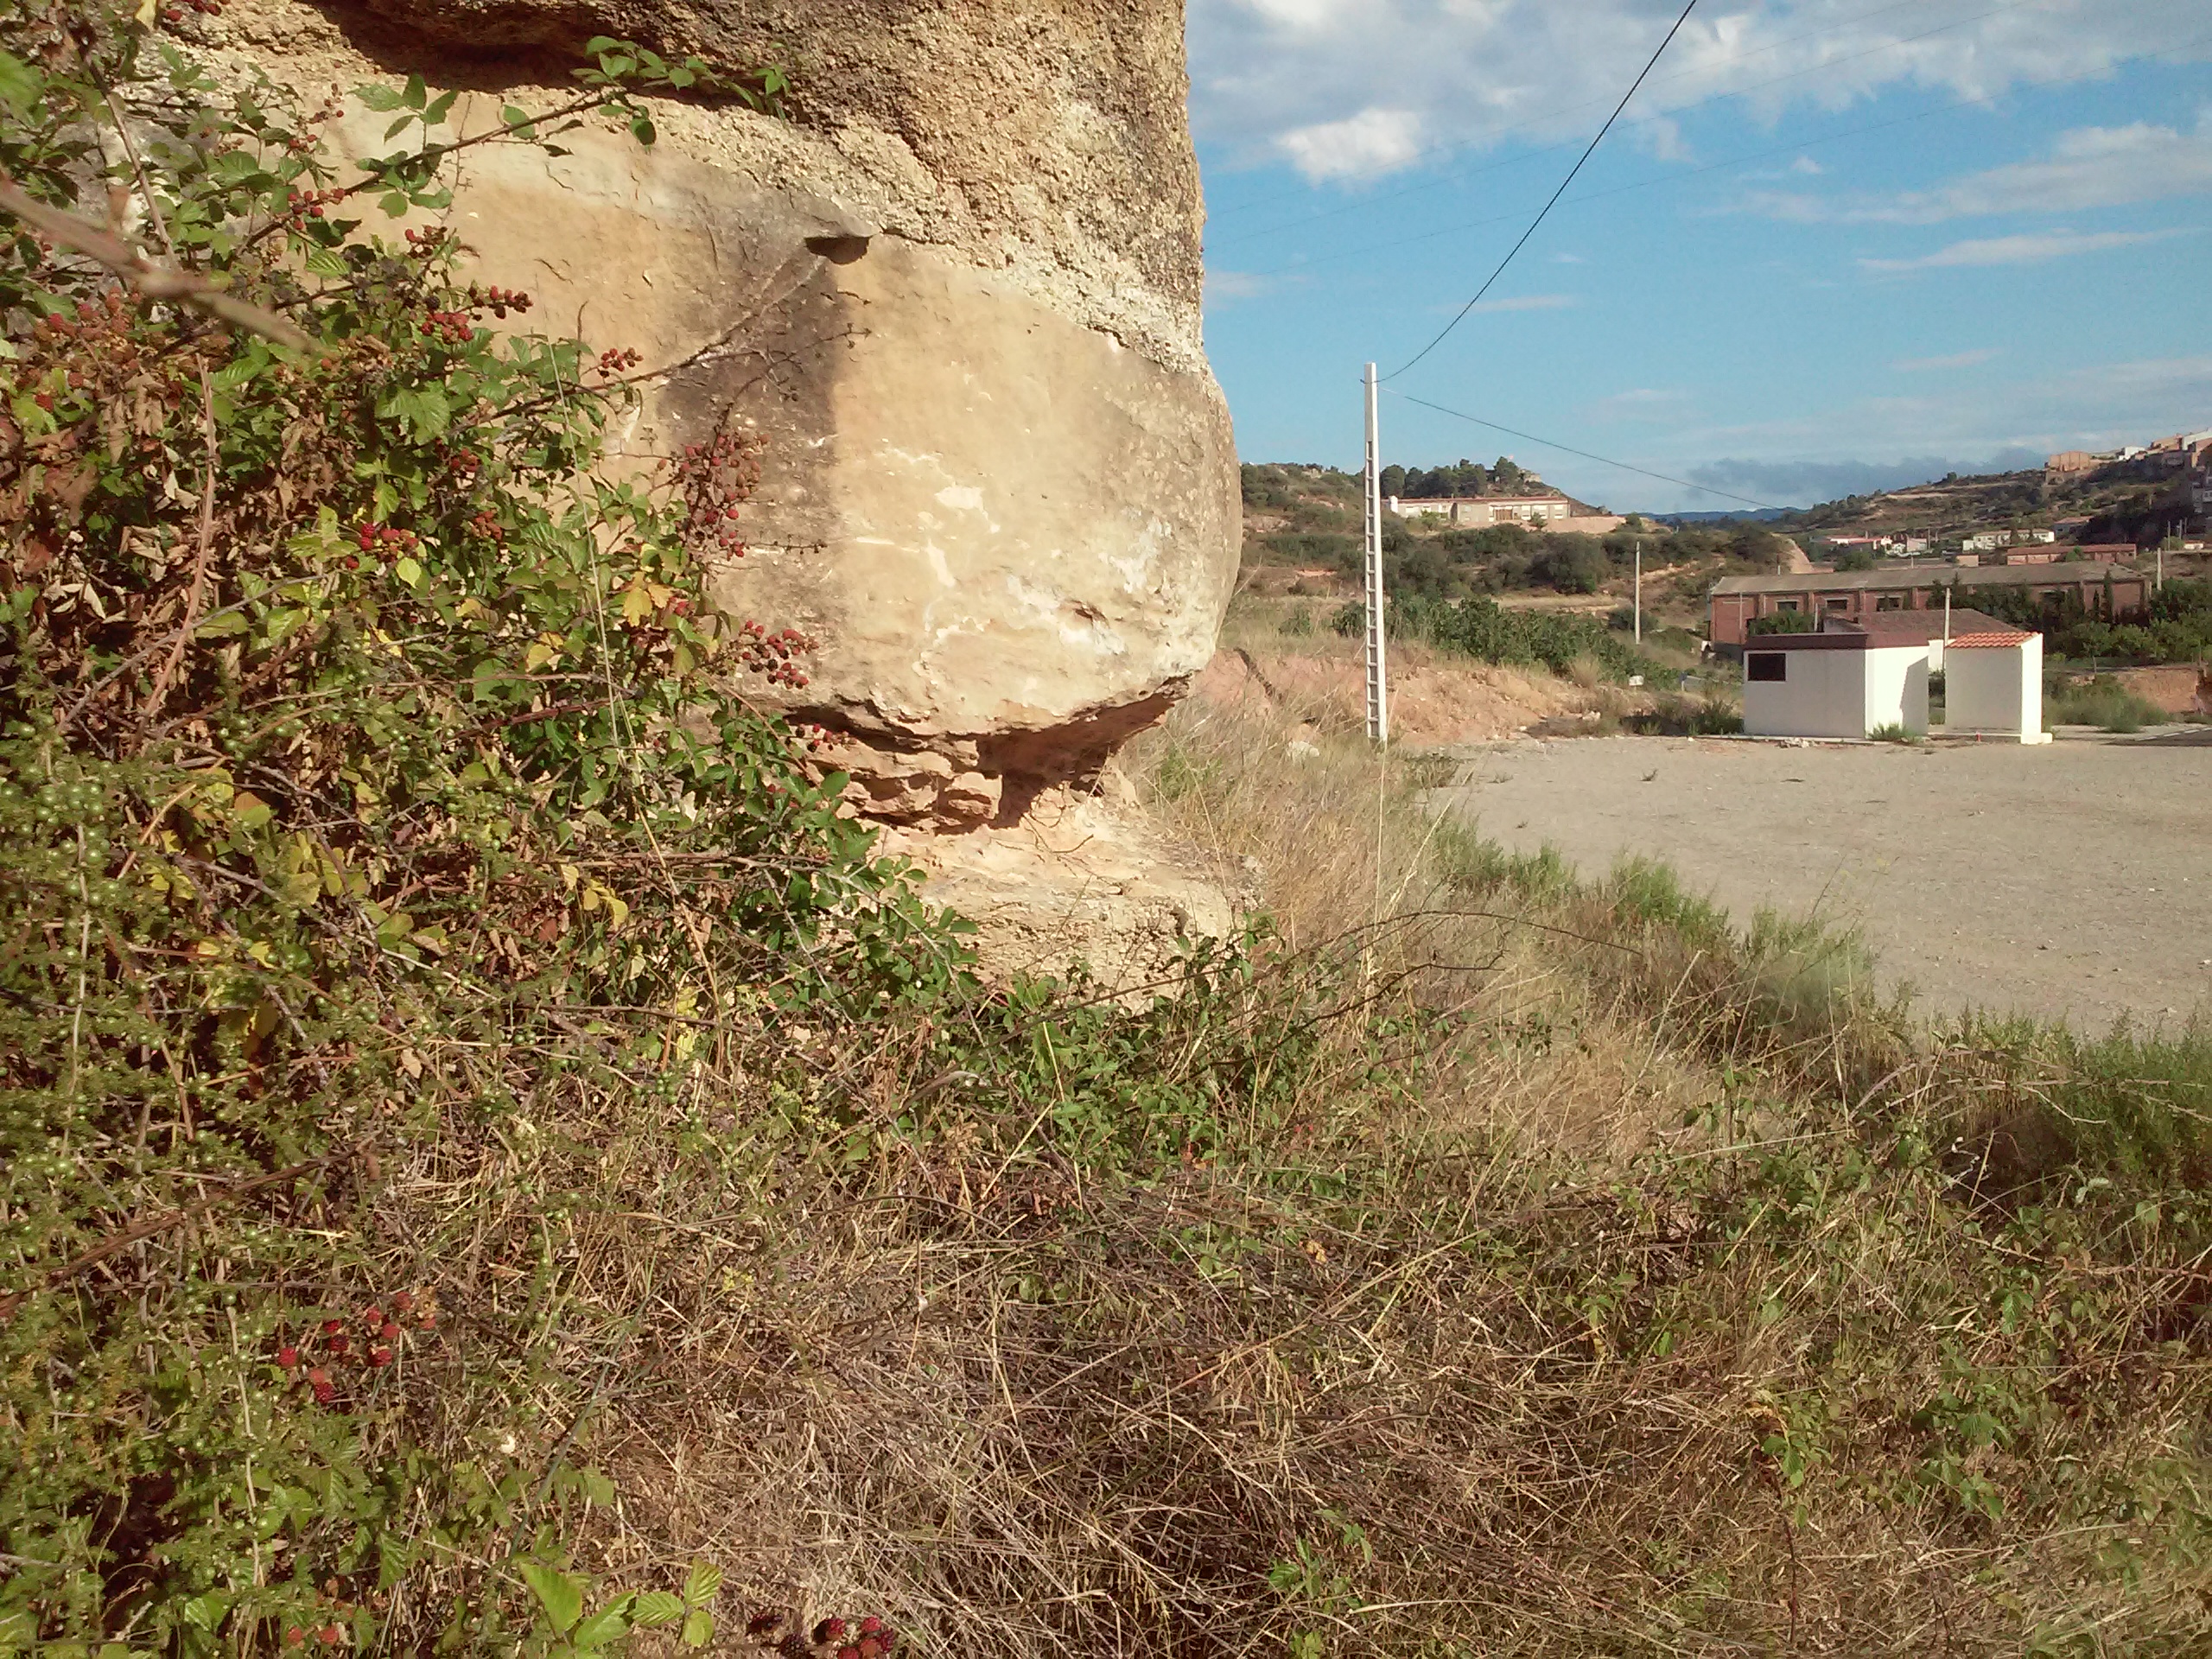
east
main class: Shrubland
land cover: Shrubland with sparse tree cover
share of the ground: > 75 %
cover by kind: shrubs 55 %, herbaceous plants 30 %, consolidated bare surface 10 %, broadleaved forest trees 5 %
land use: Semi-natural and natural areas not in use
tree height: < 5 m
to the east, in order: Shrubland with sparse tree cover; Tracks; Electric lines; Shrubland with sparse tree cover; Paved roads, cycling and walking lanes; Shrubland with sparse tree cover; Permanent industrial crops; Dry stone walls; Permanent industrial crops; Dry stone walls; Groves; Grassland with sparse tree/shrub cover; Tracks; Shrubland with sparse tree cover; Electric lines; Shrubland with sparse tree cover; Tracks; Shrubland with sparse tree cover; Olive groves; Shrubland with sparse tree cover; Electric lines; Shrubland with sparse tree cover
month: August
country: ES
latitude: 41.3778
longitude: 0.7713
